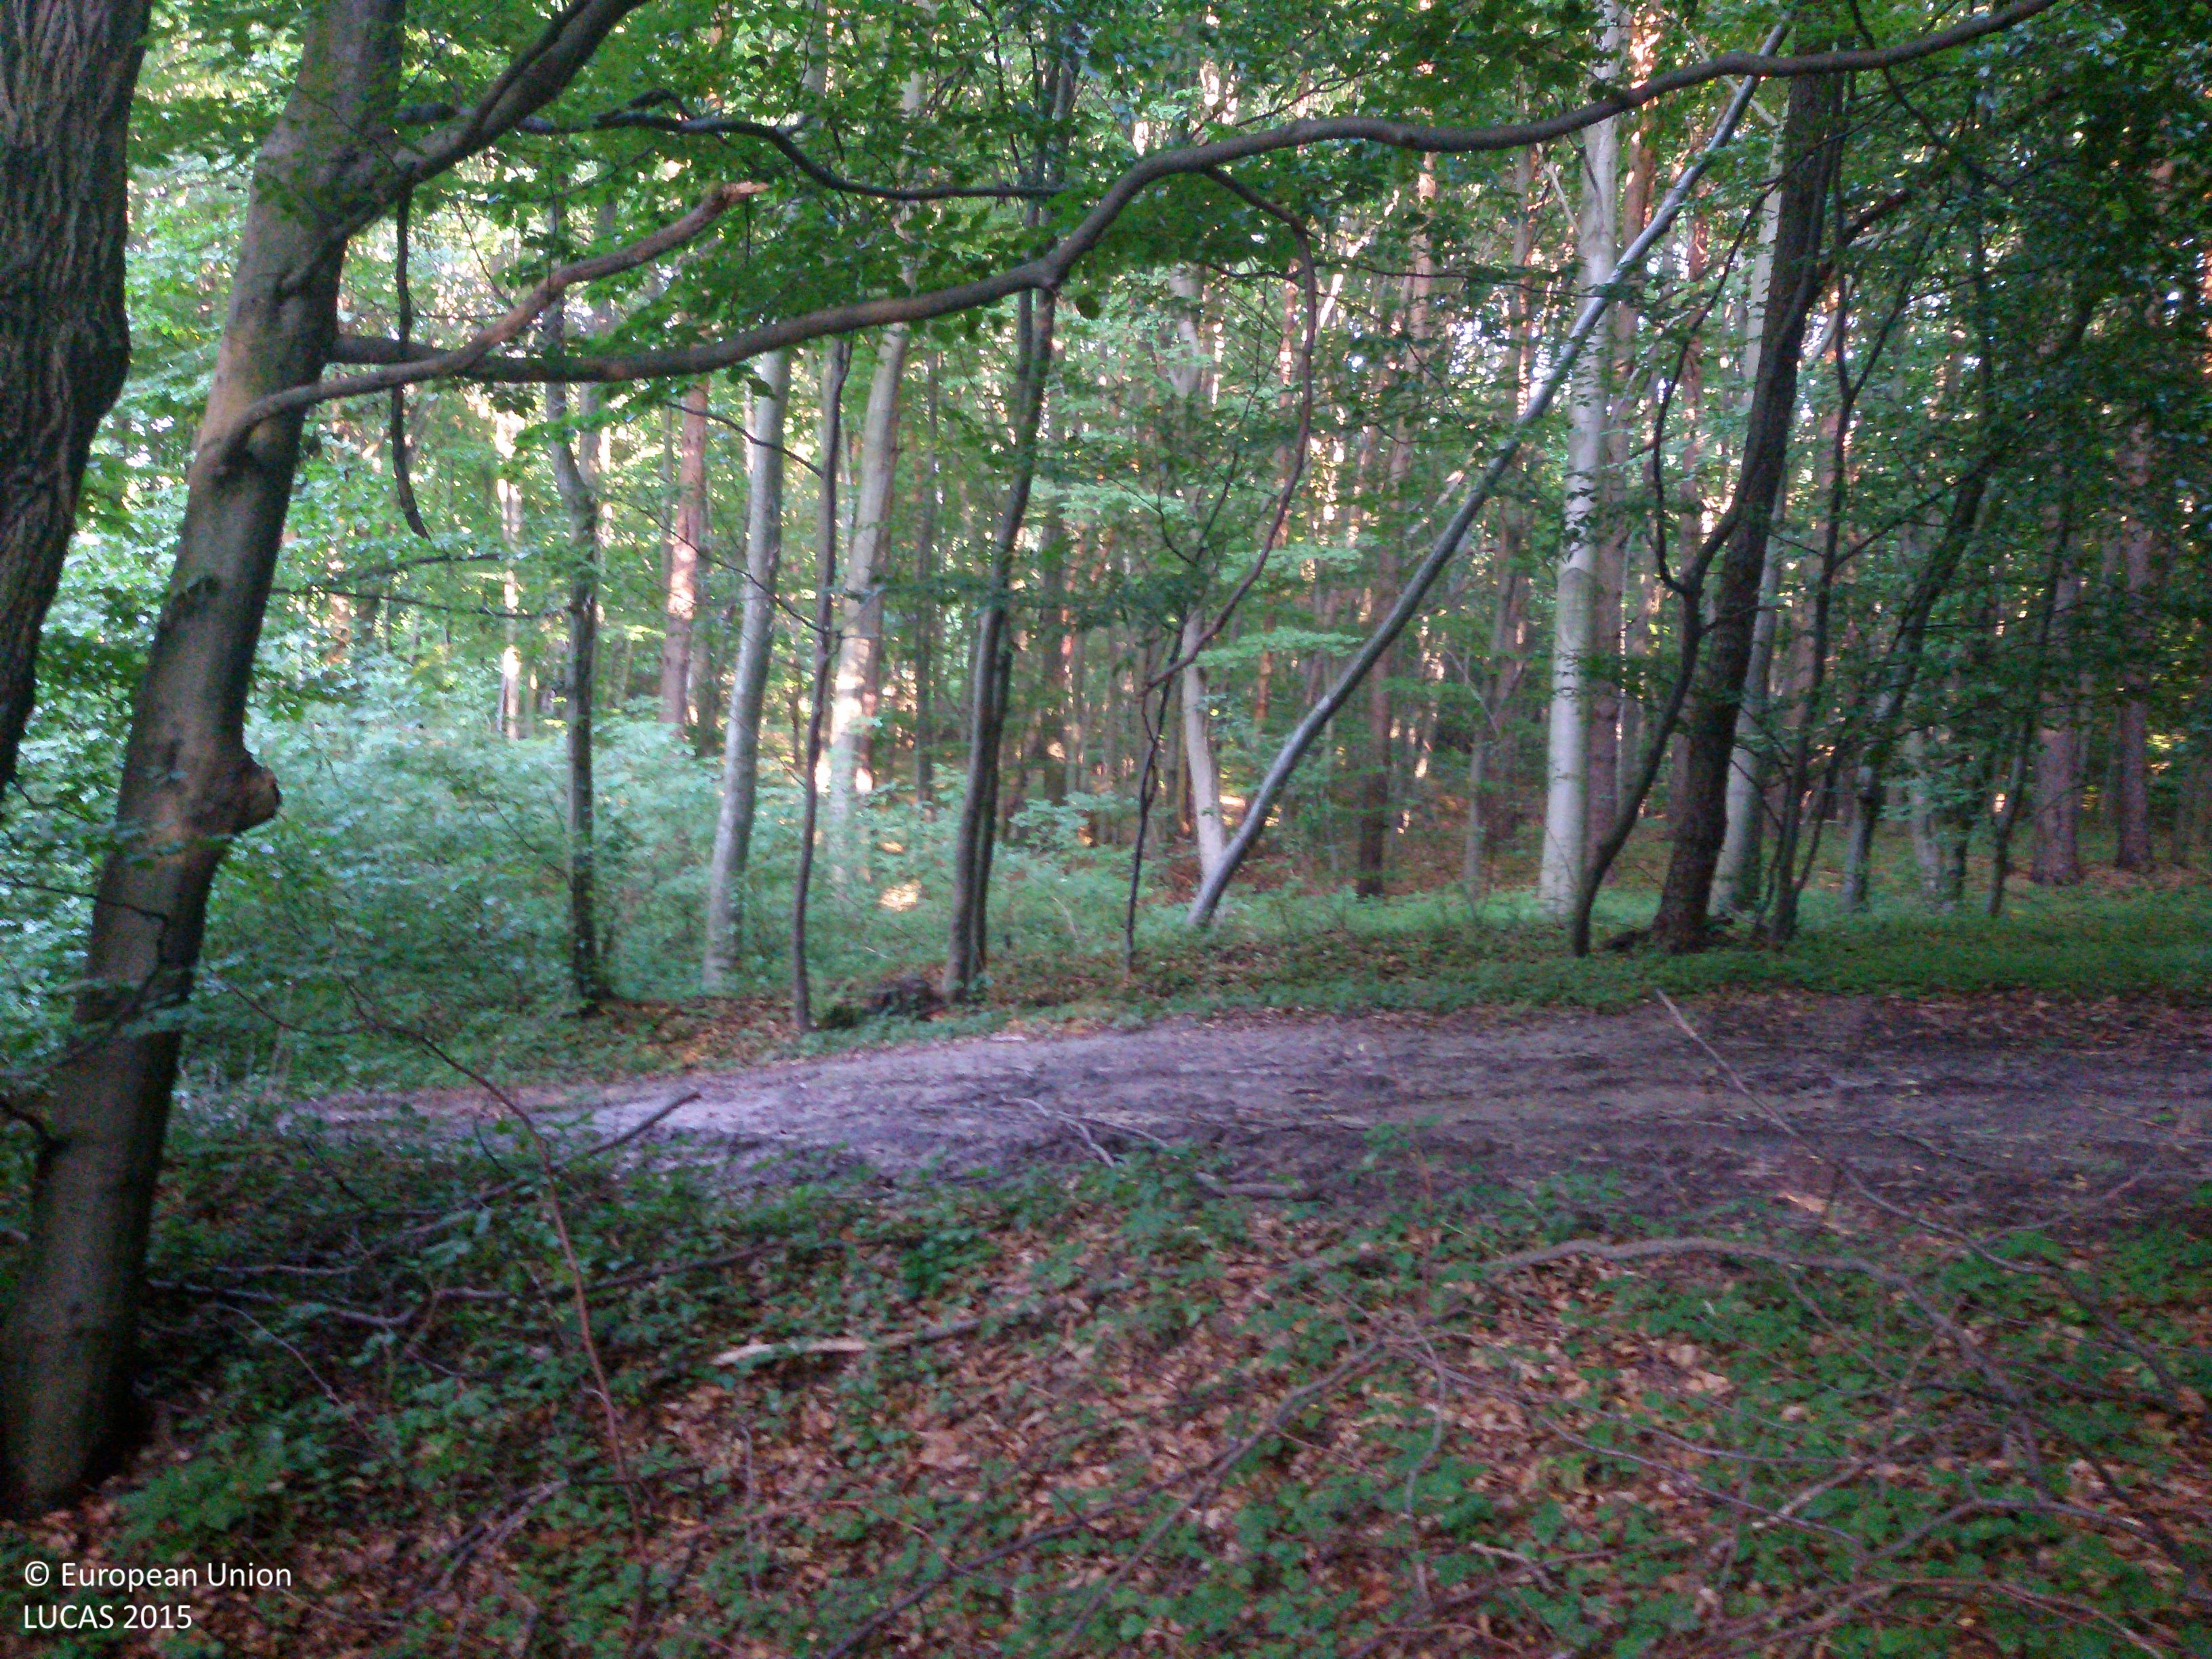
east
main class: Woodland
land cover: Broadleaved woodland
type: mesophytic deciduous forest
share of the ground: > 75 %
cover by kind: broadleaved forest trees 80 %, shrubs 10 %, herbaceous plants 10 %
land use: Forestry
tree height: > 5 m
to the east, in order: Broadleaved woodland; Tracks; Broadleaved woodland; Tracks; Broadleaved woodland
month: July
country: PL
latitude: 50.9190
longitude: 23.4111
